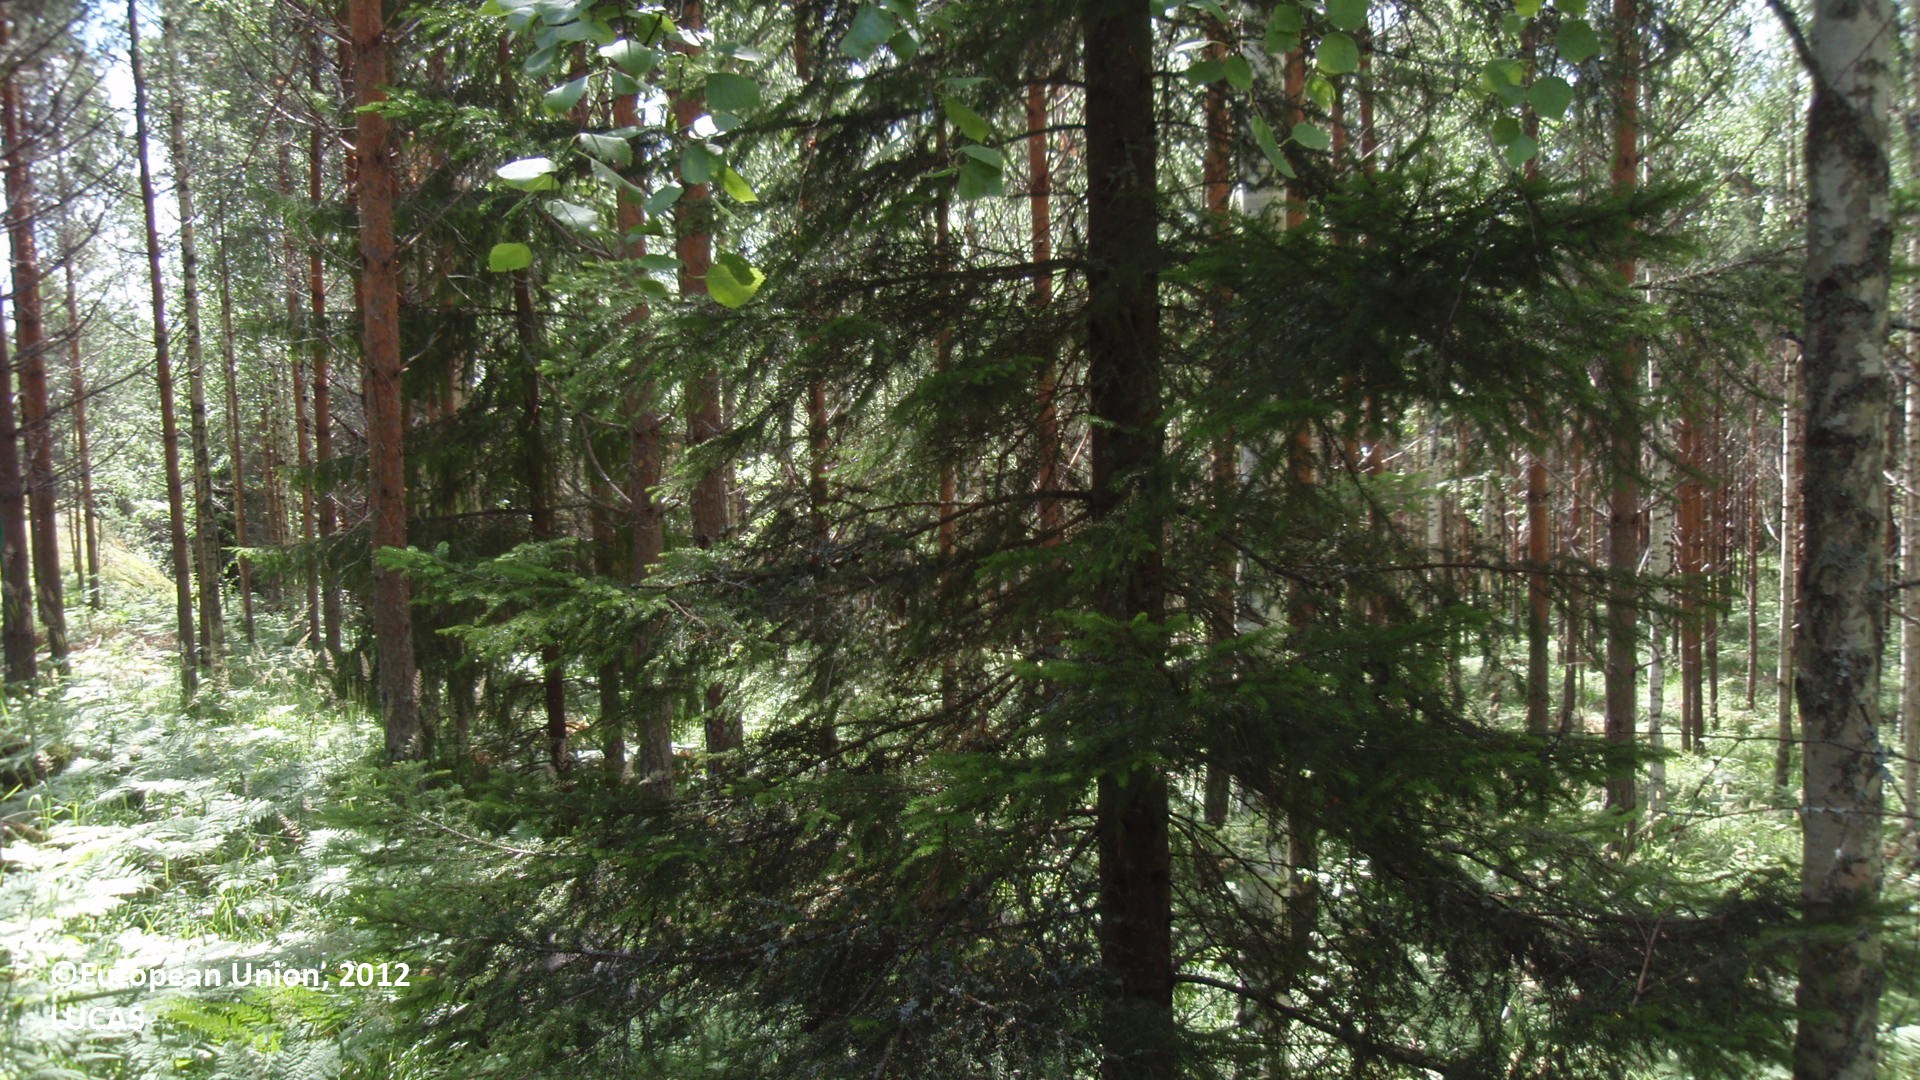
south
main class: Woodland
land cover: Pine dominated coniferous woodland
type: boreal forest
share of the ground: 50 - 75 %
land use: Forestry
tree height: > 5 m
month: July
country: FI
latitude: 61.5791
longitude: 28.4994
